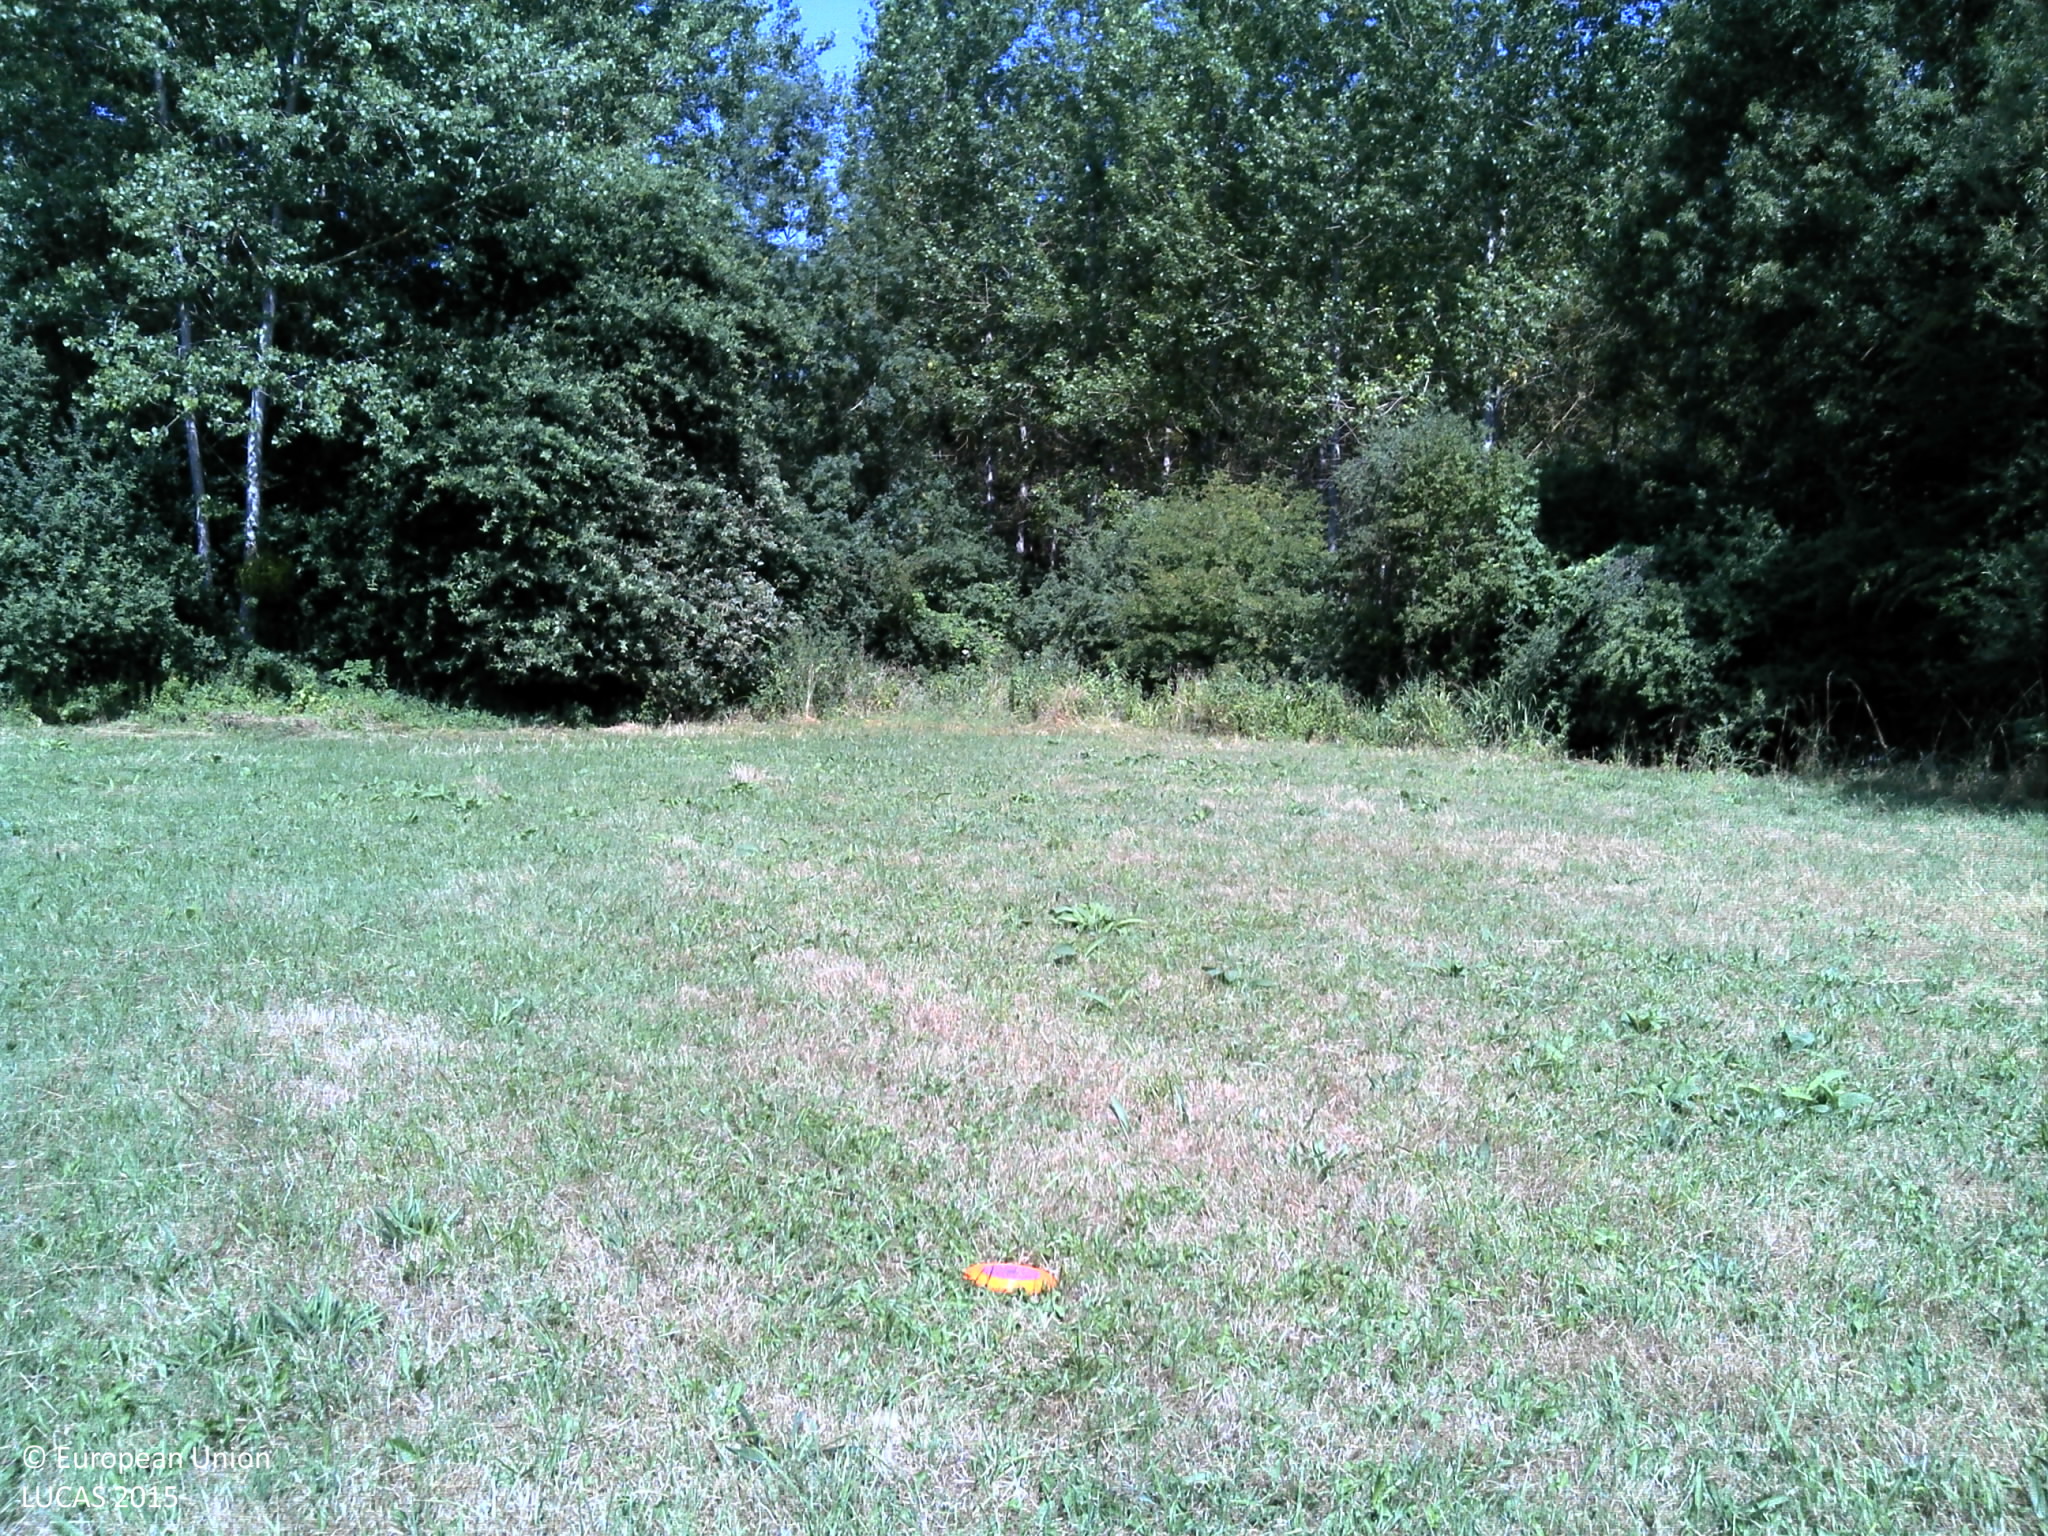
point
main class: Grassland
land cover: Grassland without tree/shrub cover
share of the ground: > 75 %
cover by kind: herbaceous plants 100 %
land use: Agriculture (excluding fallow land and kitchen gardens)
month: July
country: FR
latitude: 48.6738
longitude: 4.7148
